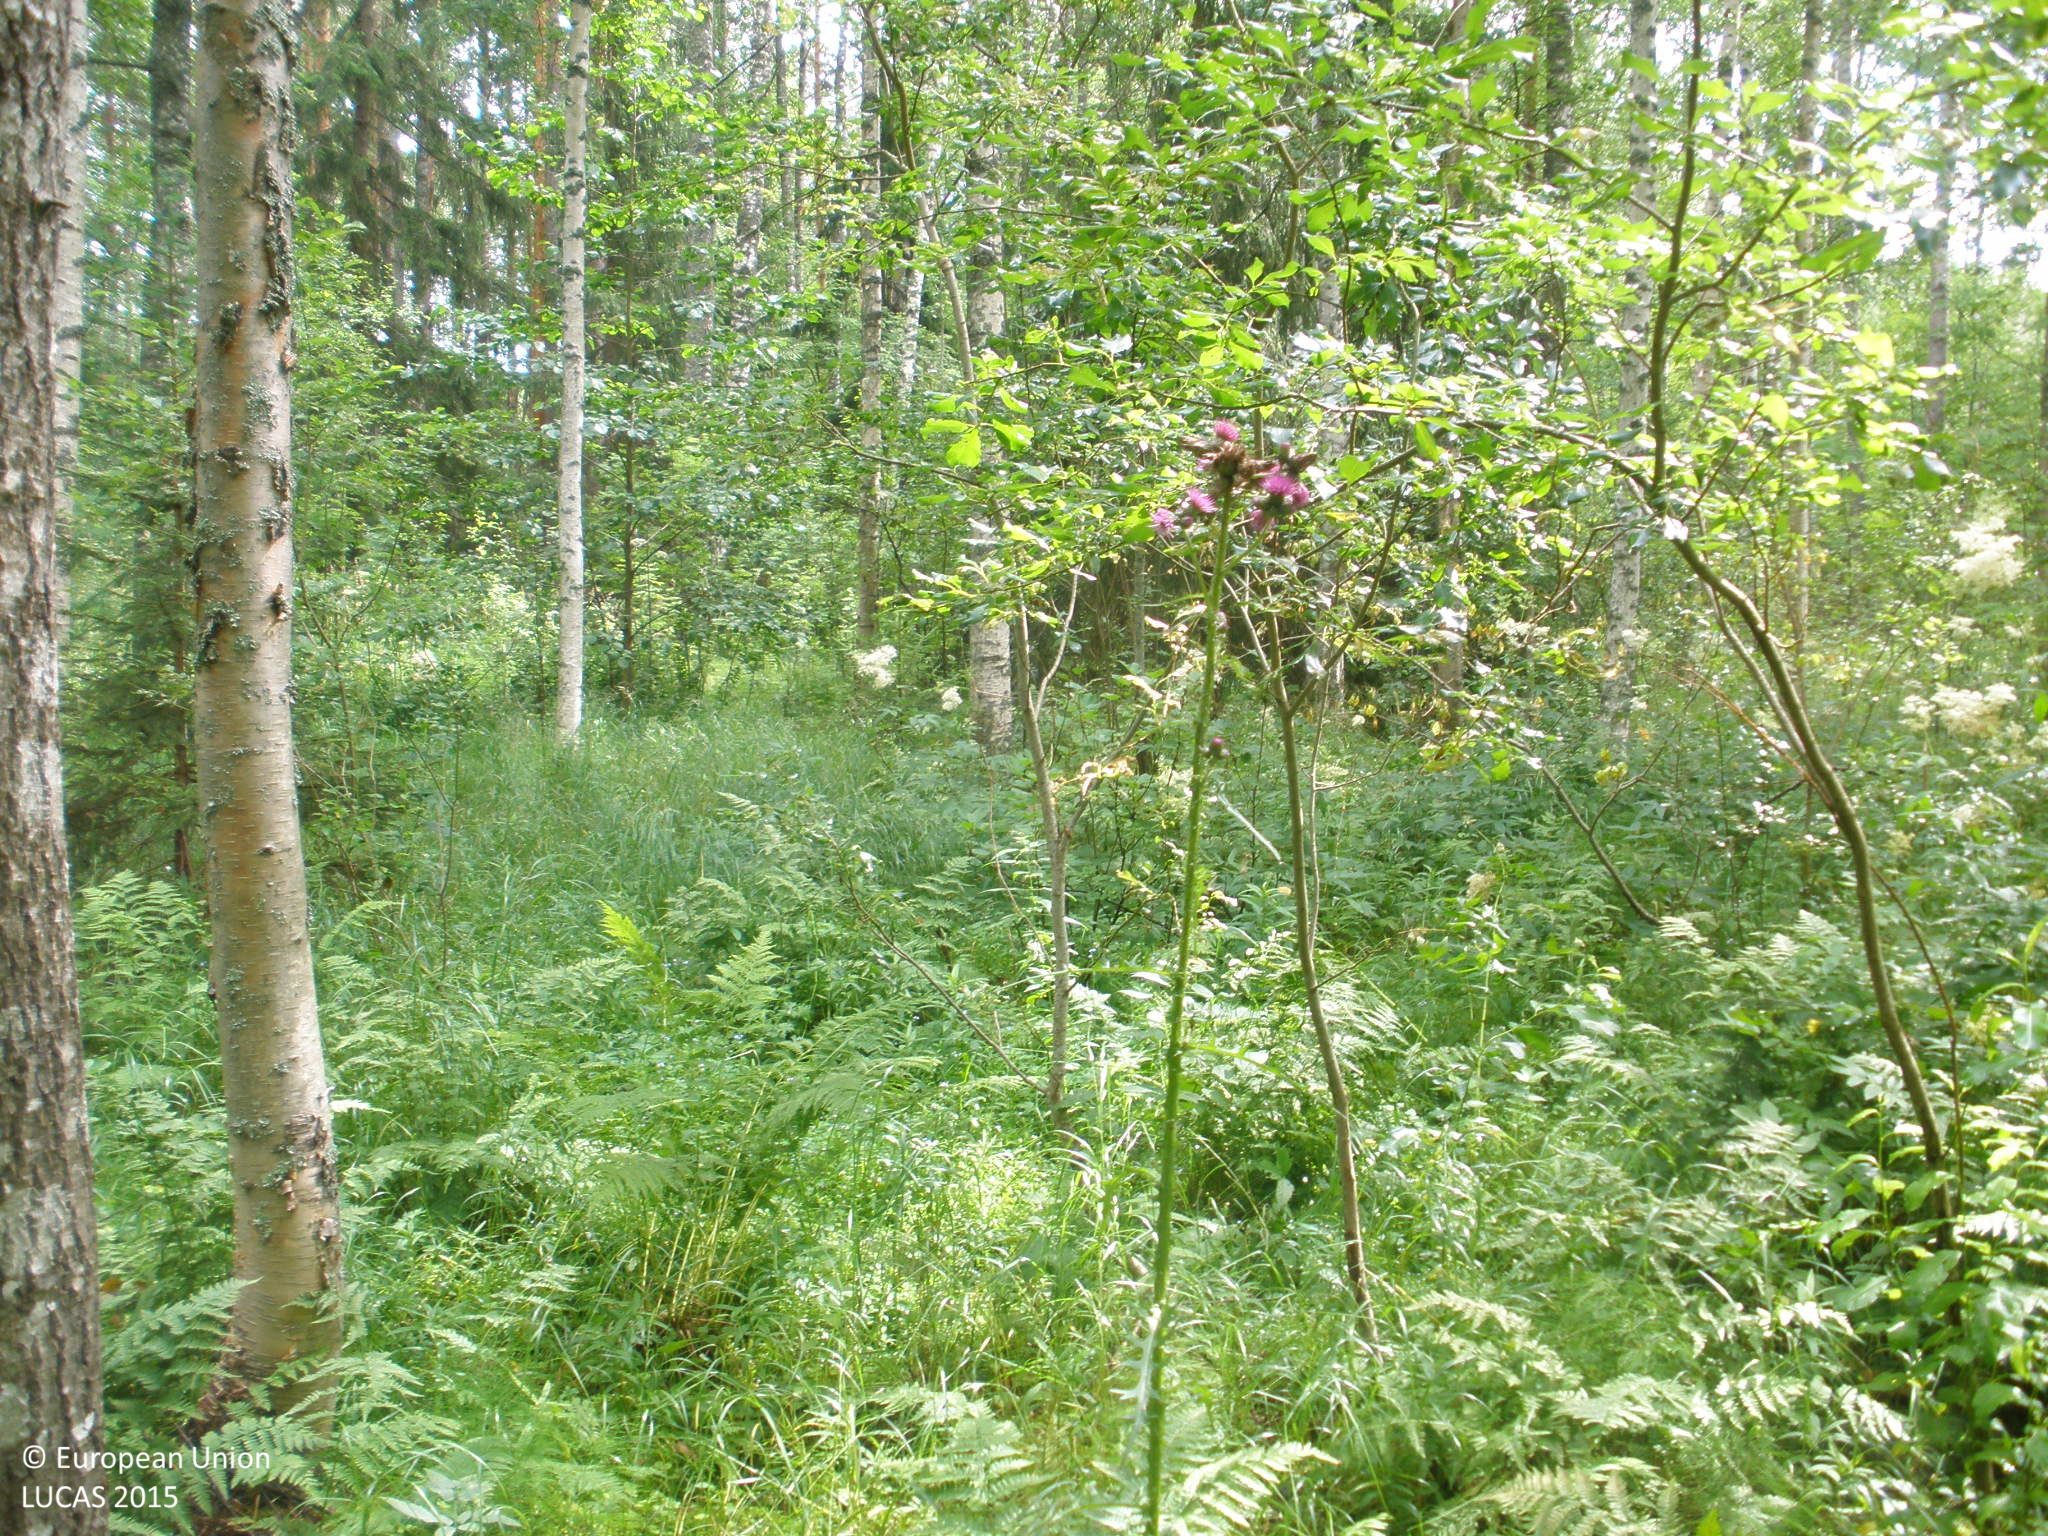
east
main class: Woodland
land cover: Broadleaved woodland
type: boreal forest
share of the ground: > 75 %
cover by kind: broadleaved forest trees 80 %, herbaceous plants 10 %, coniferous forest trees 5 %, shrubs 5 %
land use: Forestry
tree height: > 5 m
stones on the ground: 10 - 25 %
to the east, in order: Broadleaved woodland; Pine dominated mixed woodland; Paved roads, cycling and walking lanes; Pine dominated mixed woodland; Temporary grasslands; Rivers and streams; Temporary grasslands; Grass margins; Ditches and canals; Other mixed woodland; Grass margins; Ditches and canals; Grass margins; Temporary grasslands; Grass margins; Electric lines; Grass margins; Artificial constructions in urban areas; Pine dominated coniferous woodland
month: July
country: FI
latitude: 61.3298
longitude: 24.7351
